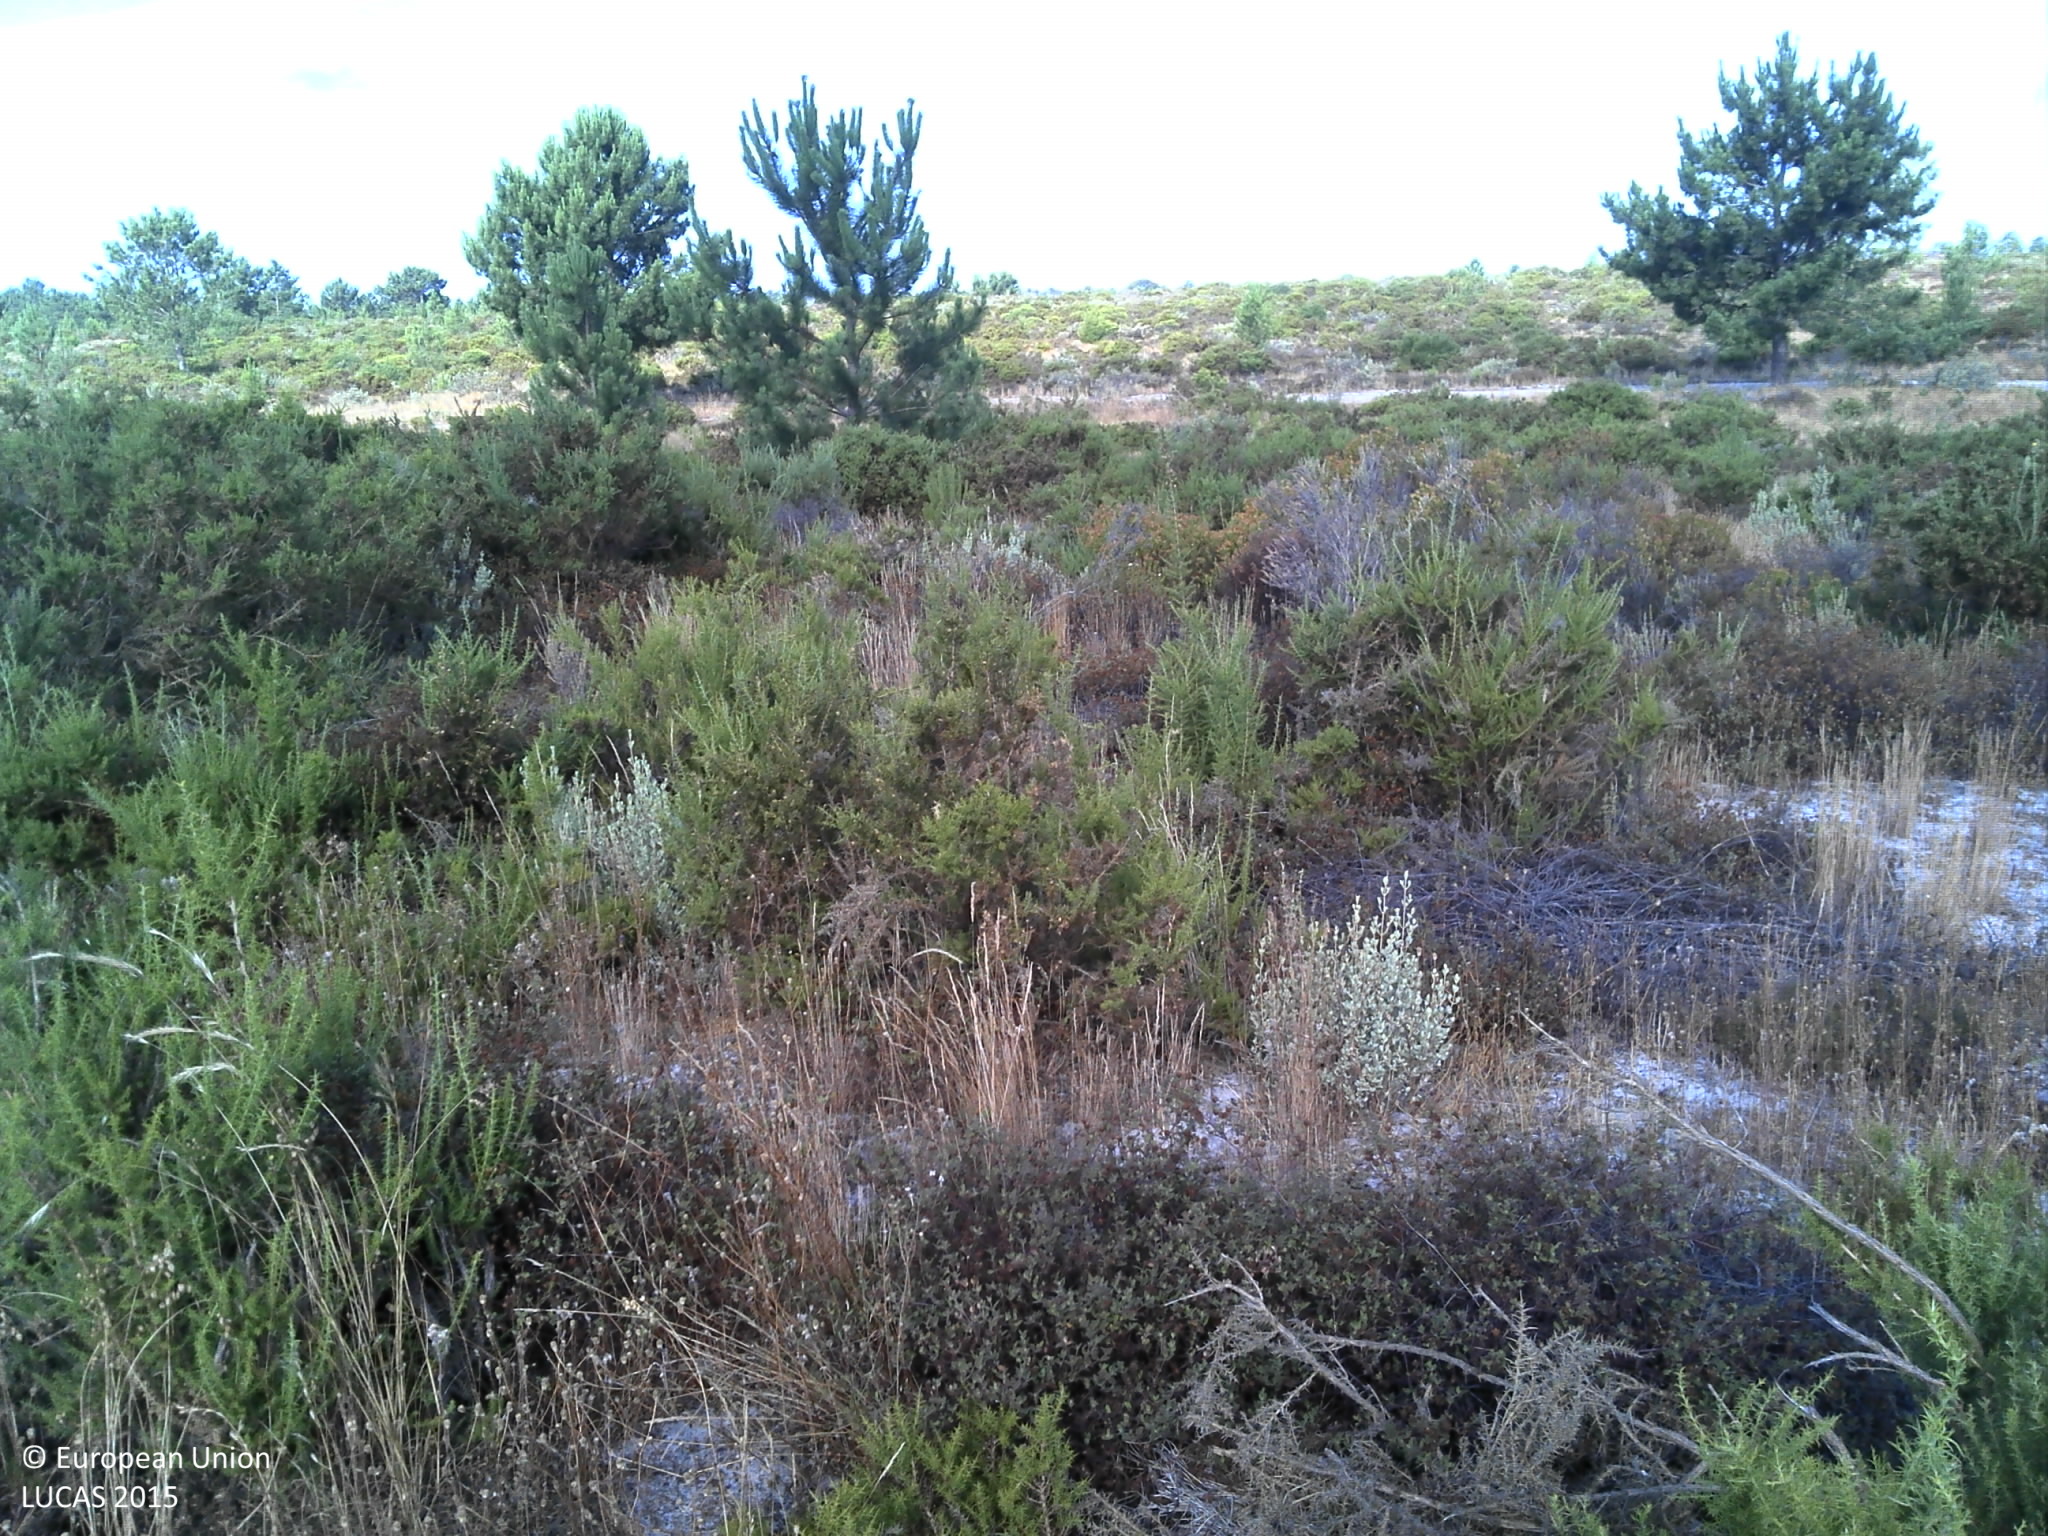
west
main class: Shrubland
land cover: Shrubland with sparse tree cover
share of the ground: 25 - 50 %
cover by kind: shrubs 40 %, unconsolidated bare surface 35 %, herbaceous plants 20 %, coniferous forest trees 5 %
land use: Semi-natural and natural areas not in use
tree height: < 5 m
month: July
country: PT
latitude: 38.5022
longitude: -9.0926
